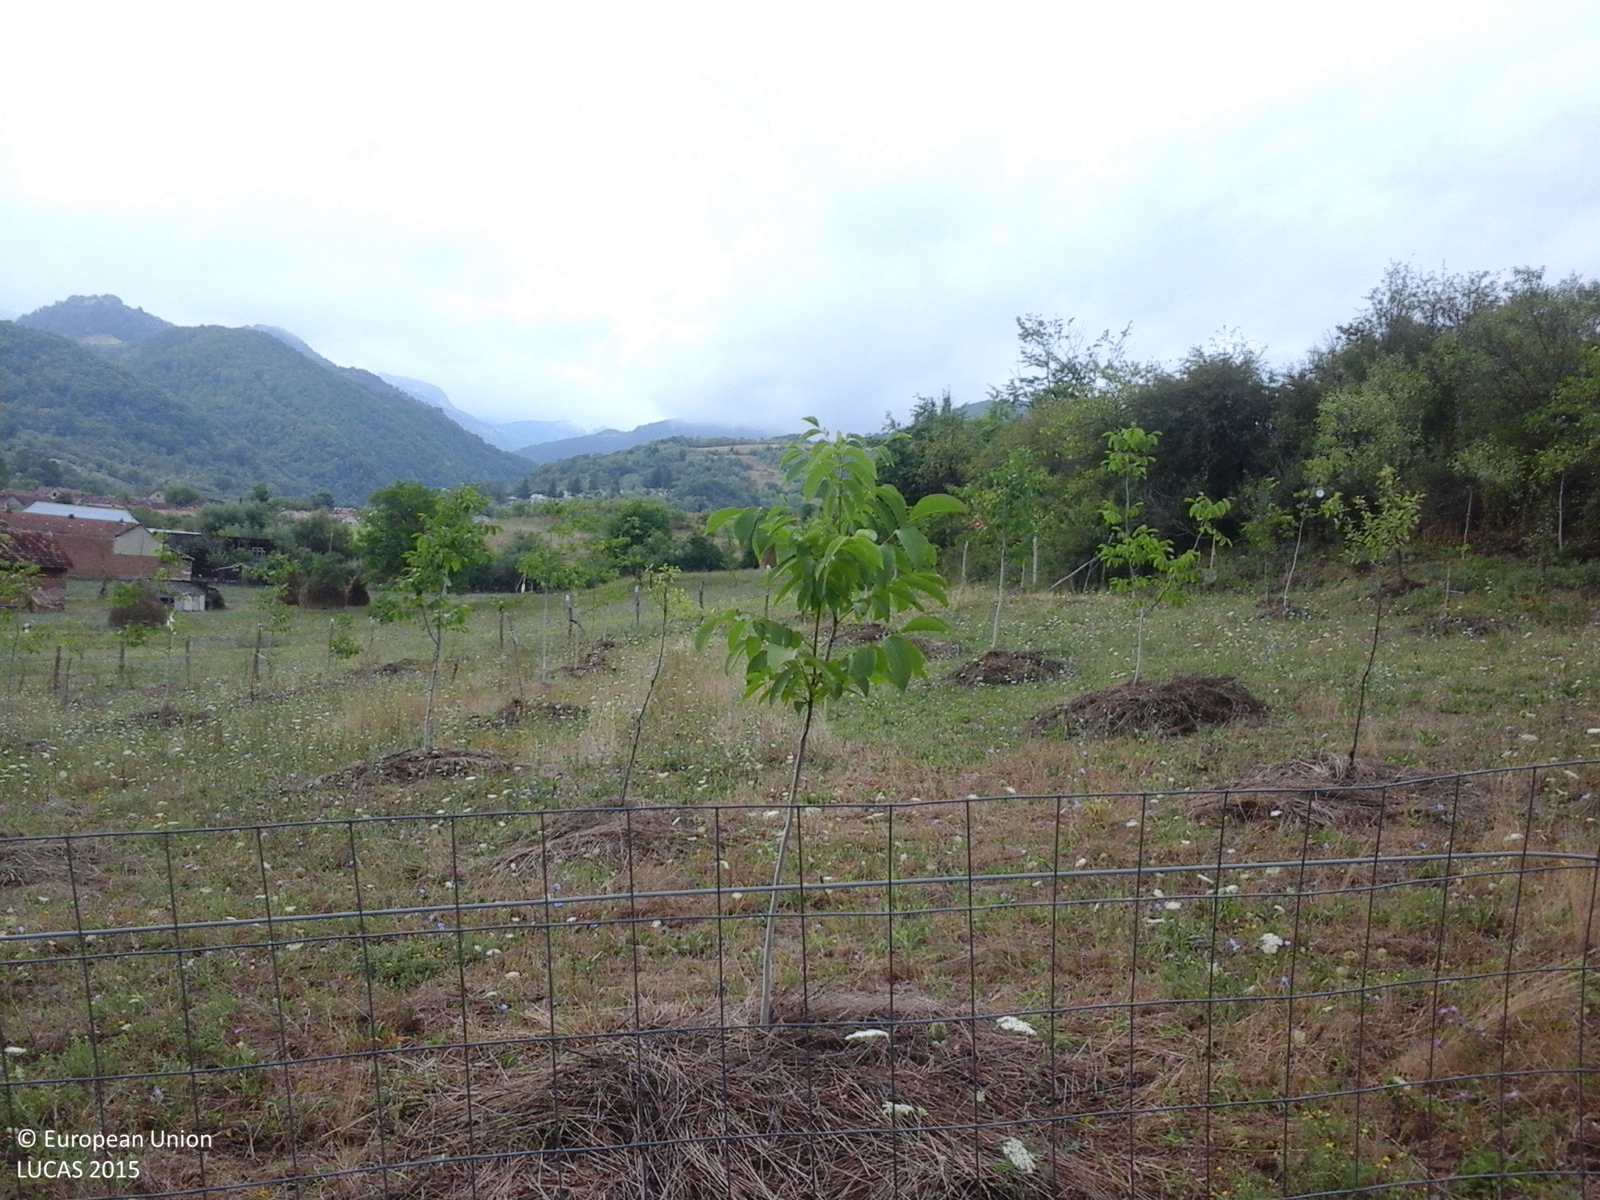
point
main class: Cropland
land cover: Nuts trees
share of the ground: 25 - 50 %
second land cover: Grassland without tree/shrub cover
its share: > 75 %
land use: Agriculture (excluding fallow land and kitchen gardens)
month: August
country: RO
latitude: 44.8959
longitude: 21.9498
